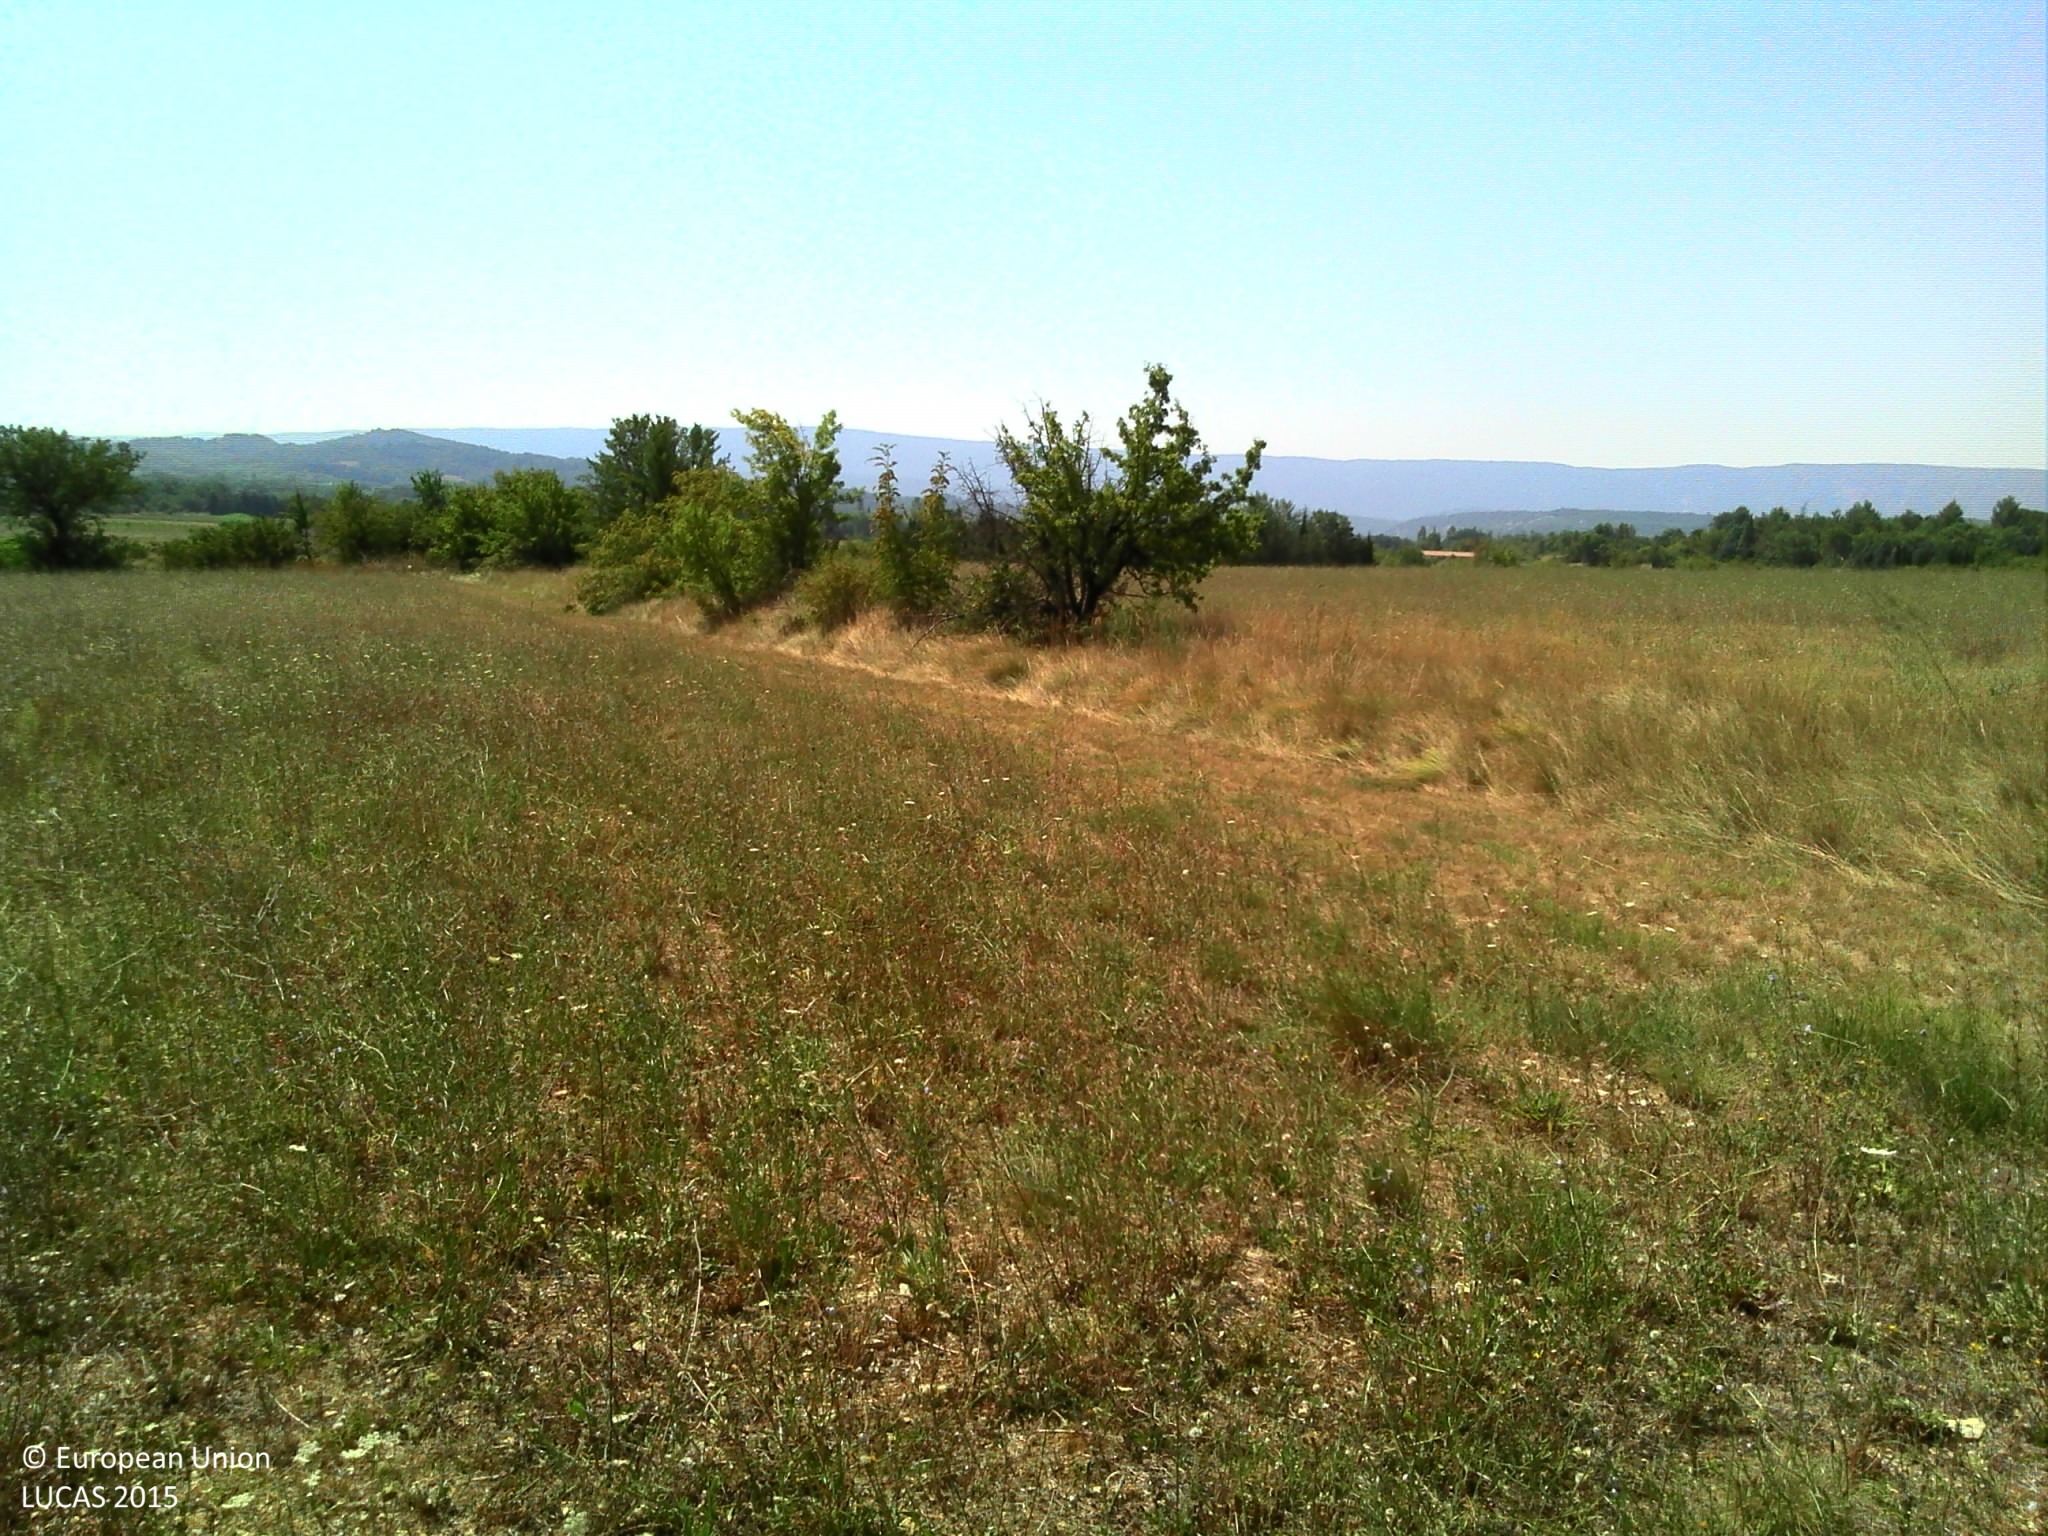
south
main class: Grassland
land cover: Grassland without tree/shrub cover
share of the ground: > 75 %
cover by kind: herbaceous plants 90 %, consolidated bare surface 10 %
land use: Agriculture (excluding fallow land and kitchen gardens)
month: August
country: FR
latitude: 43.9161
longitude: 5.2390
